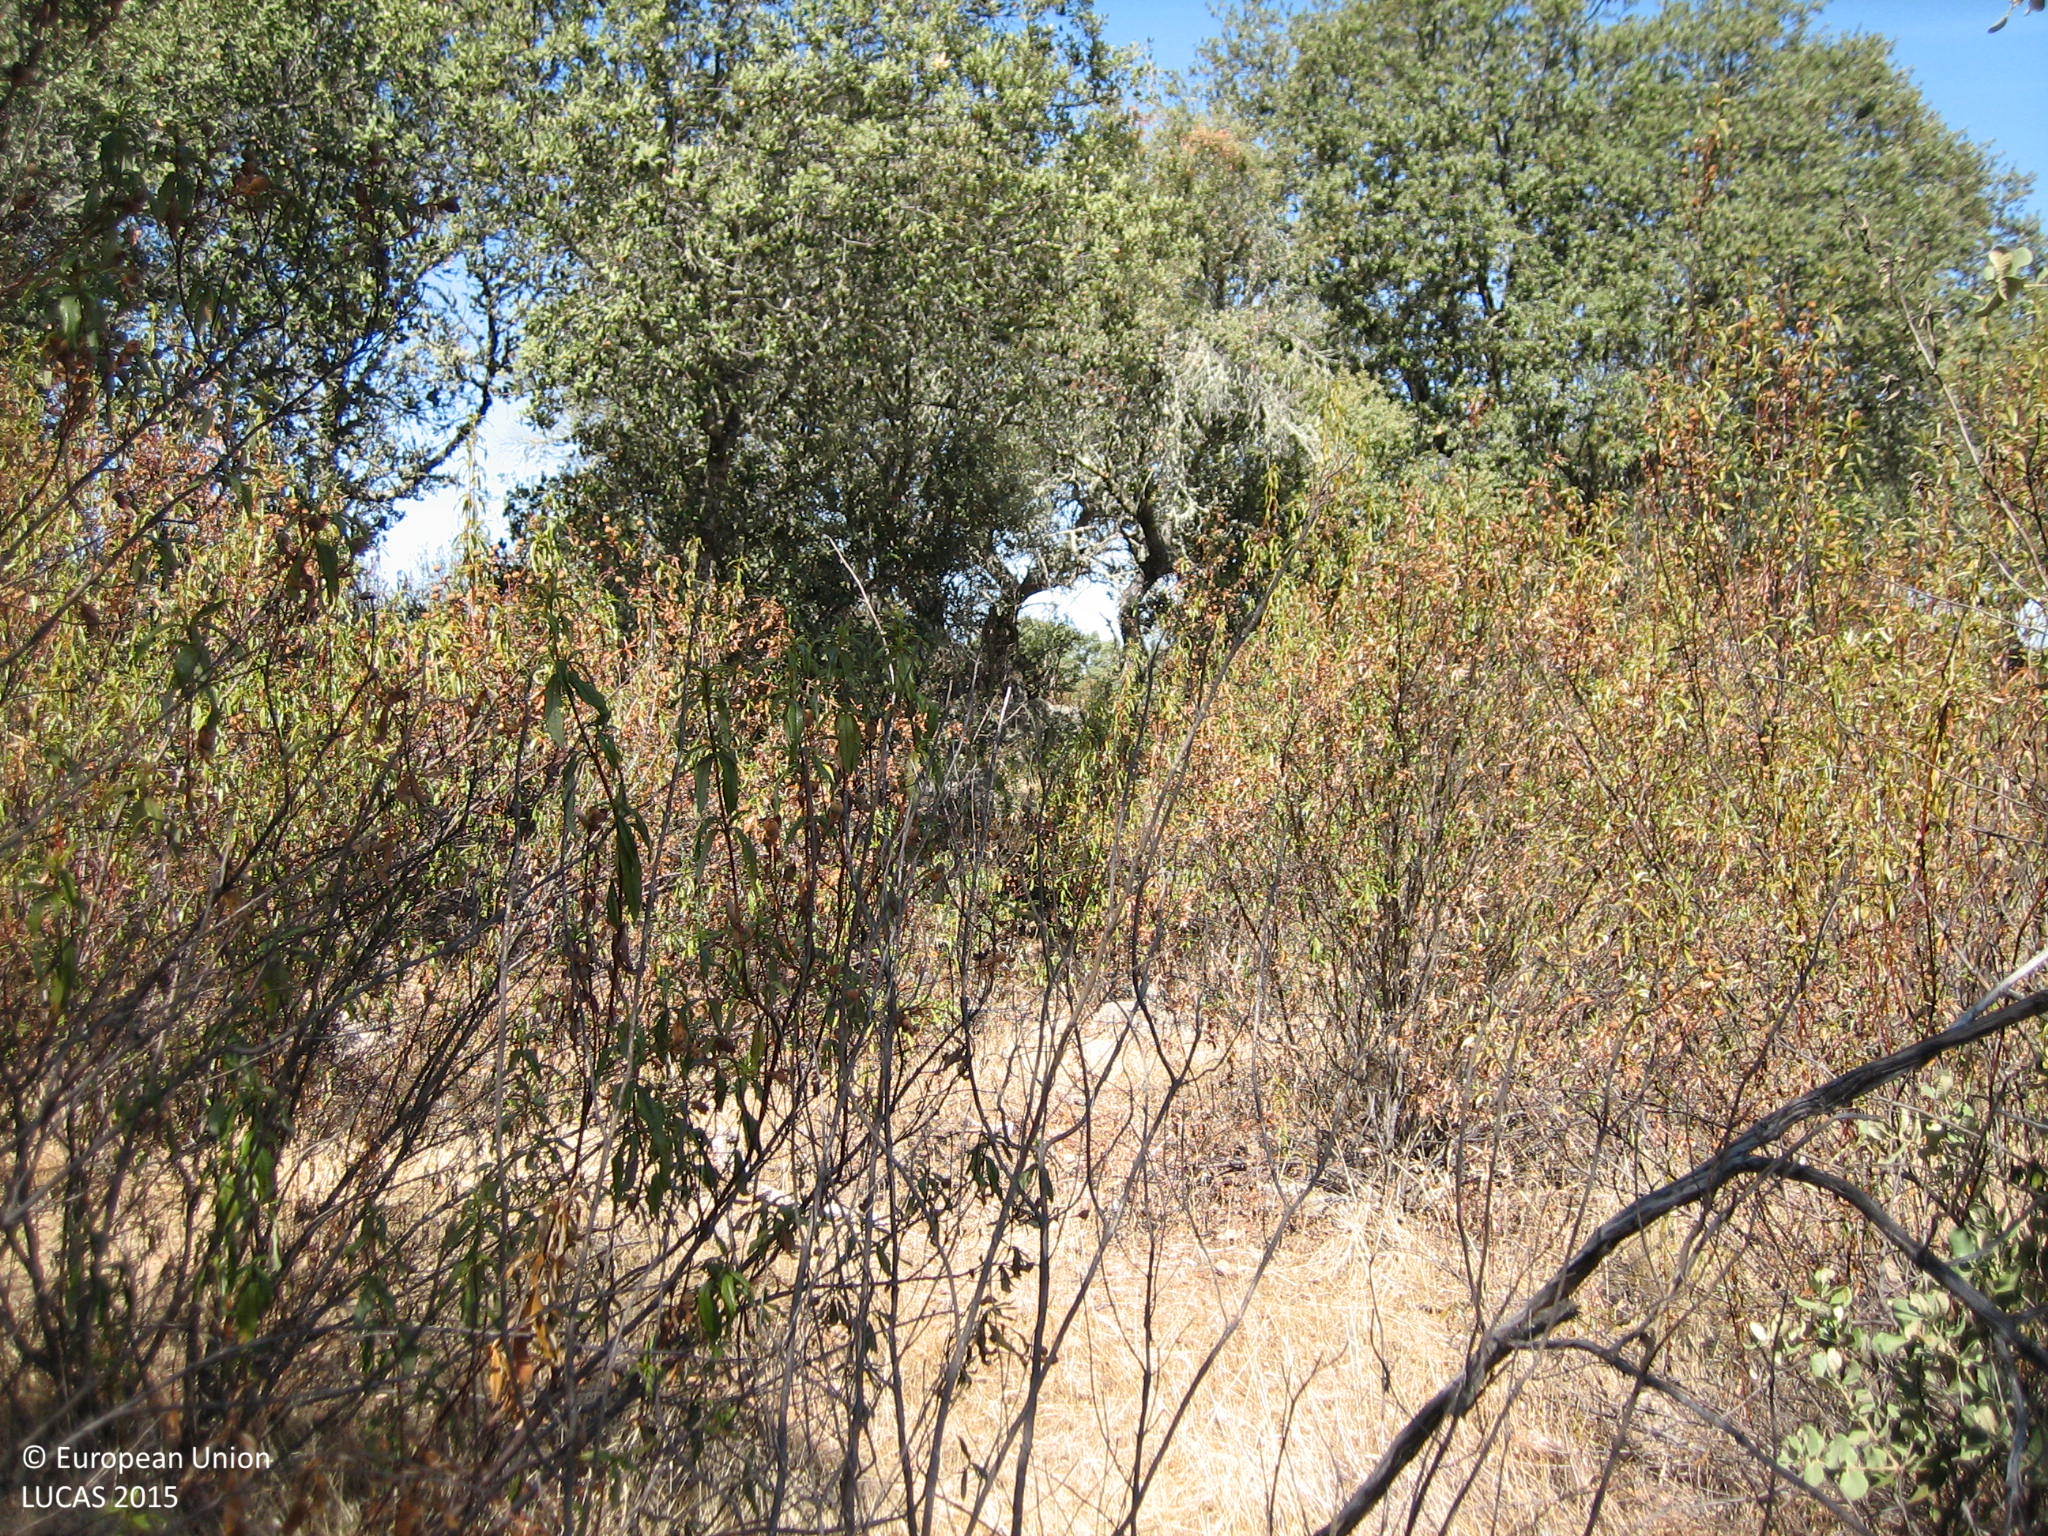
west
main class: Shrubland
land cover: Shrubland with sparse tree cover
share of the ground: 50 - 75 %
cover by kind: shrubs 60 %, herbaceous plants 35 %, broadleaved forest trees 5 %
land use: Agriculture (excluding fallow land and kitchen gardens)
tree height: < 5 m
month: August
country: ES
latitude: 38.4546
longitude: -7.2217
